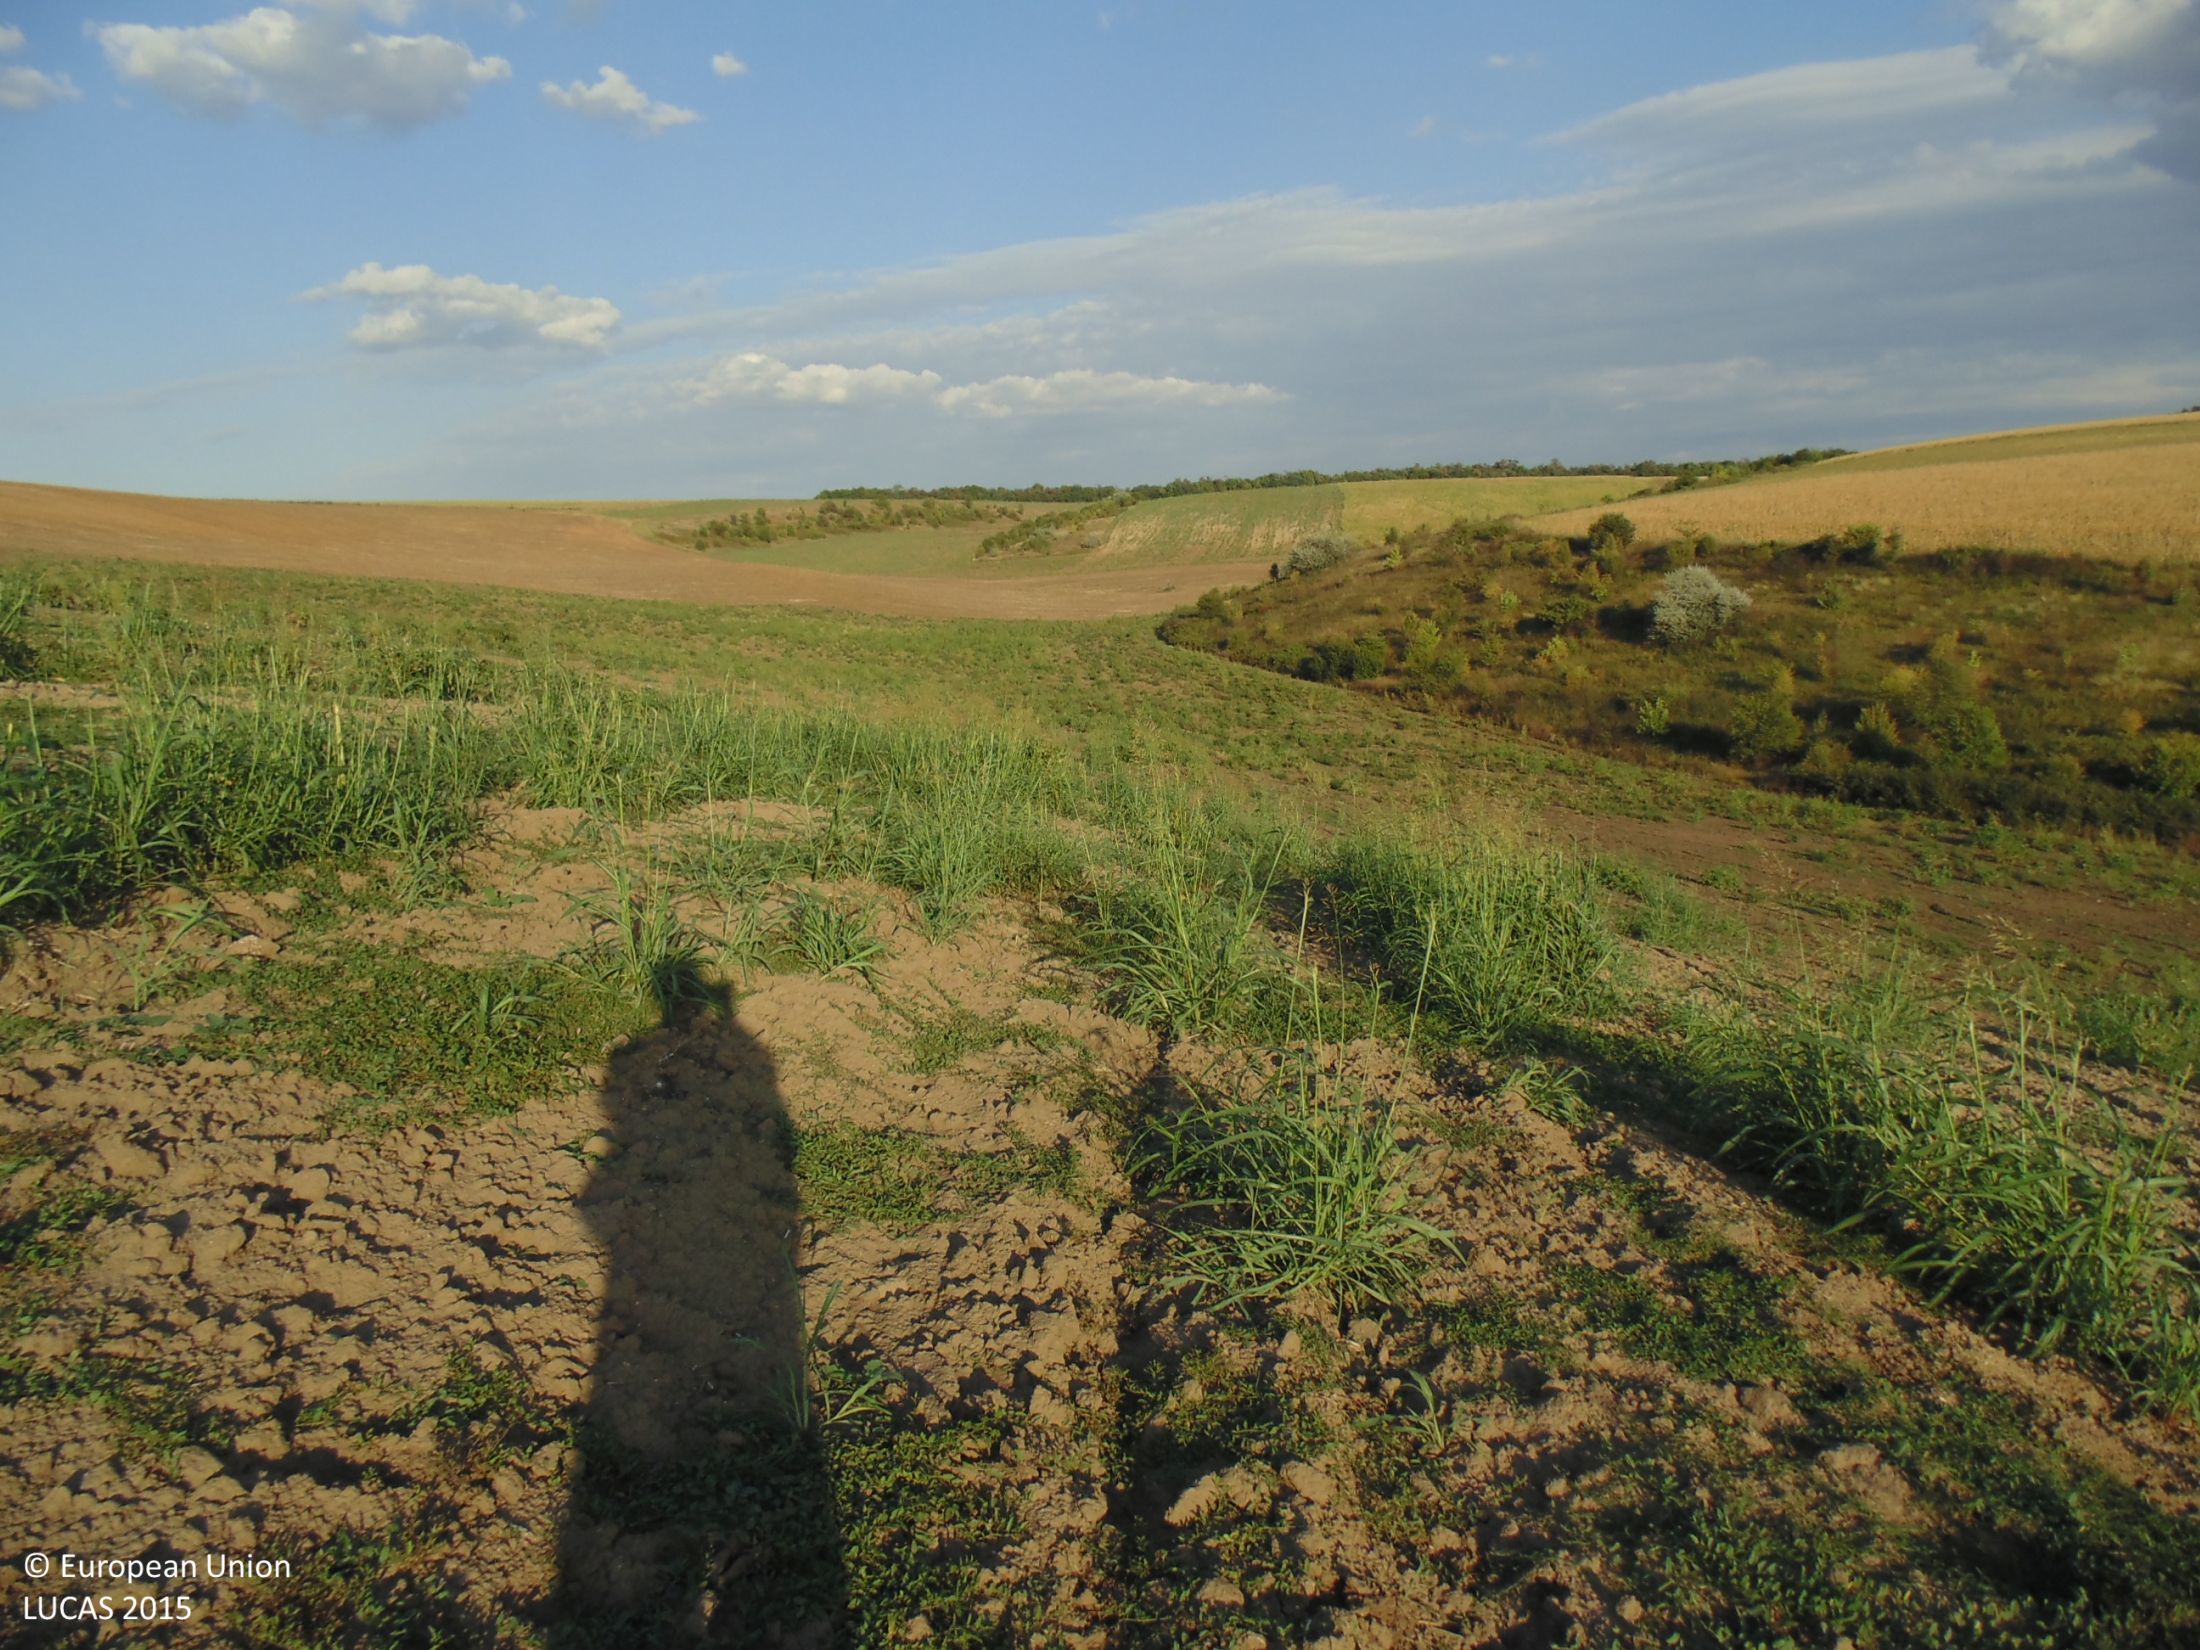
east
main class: Cropland
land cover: Rape and turnip rape
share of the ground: < 10 %
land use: Agriculture (excluding fallow land and kitchen gardens)
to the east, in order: Rape and turnip rape
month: September
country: BG
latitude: 44.0567
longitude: 27.1161
